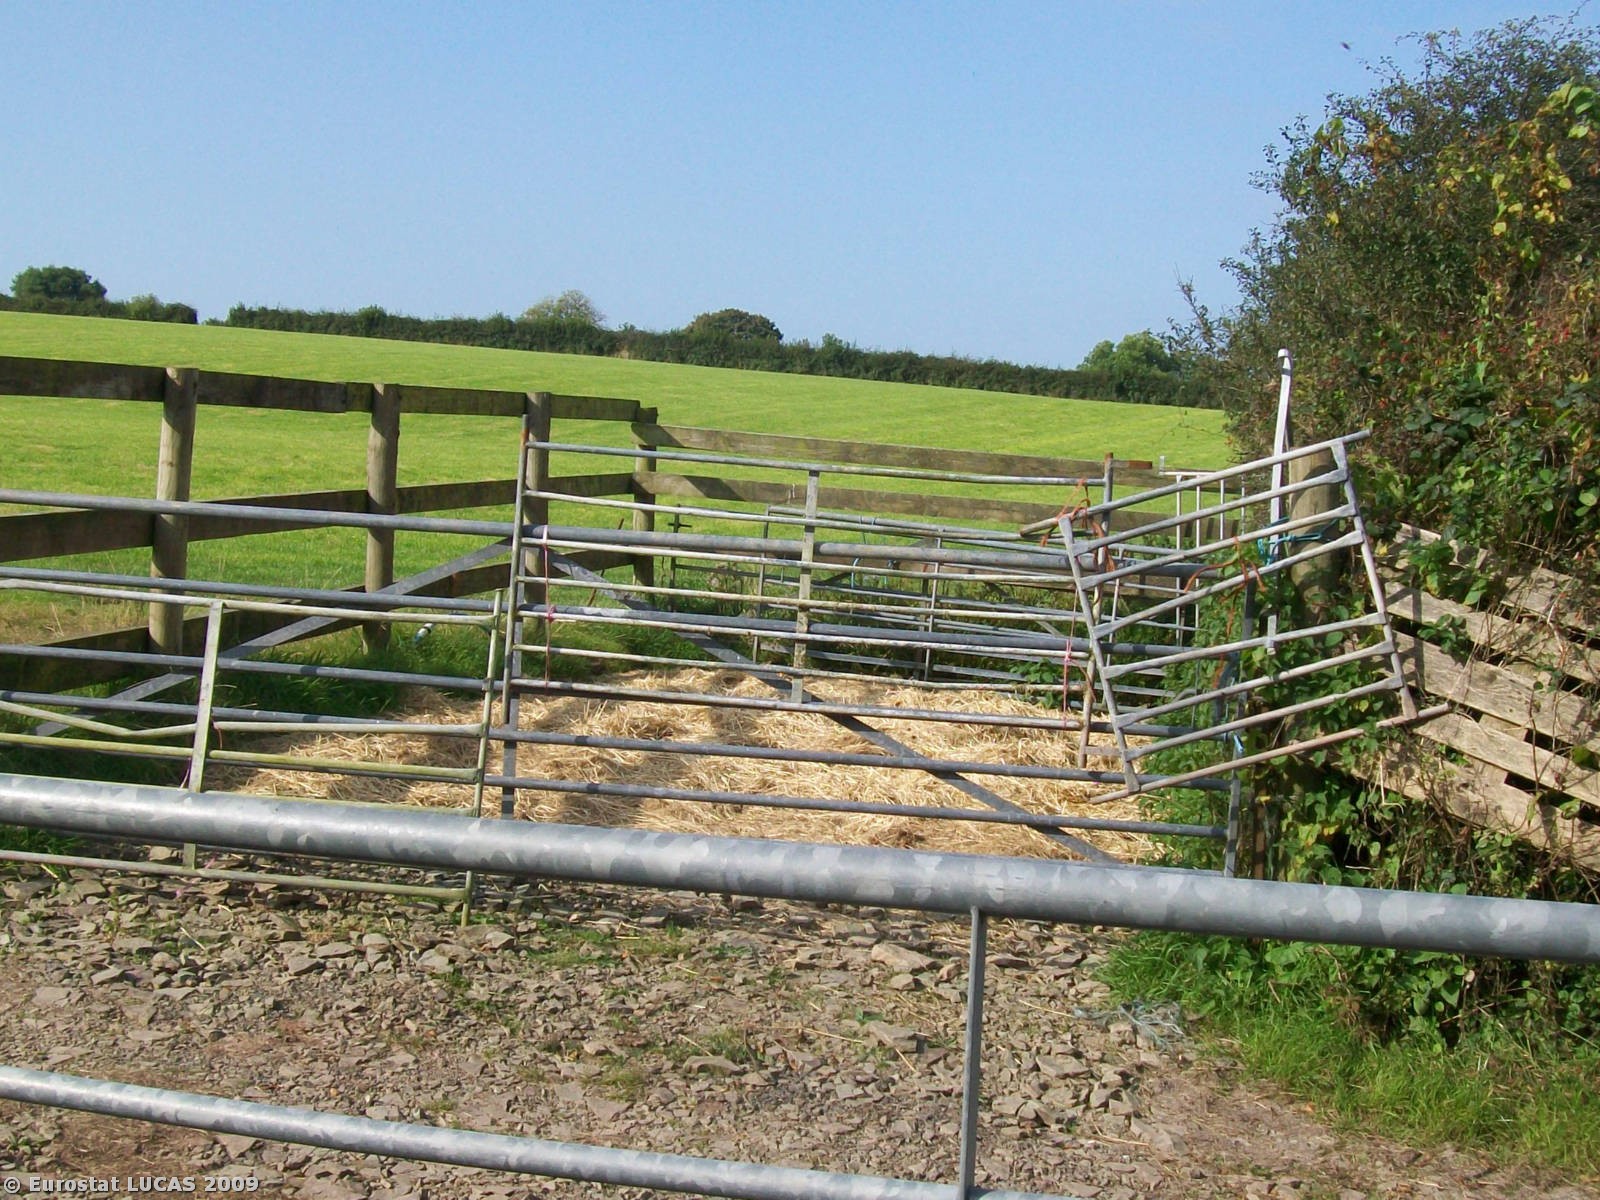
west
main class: Grassland
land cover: Grassland without tree/shrub cover
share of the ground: > 75 %
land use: Agriculture (excluding fallow land and kitchen gardens)
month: September
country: GB
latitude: 51.7836
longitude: -4.7076
